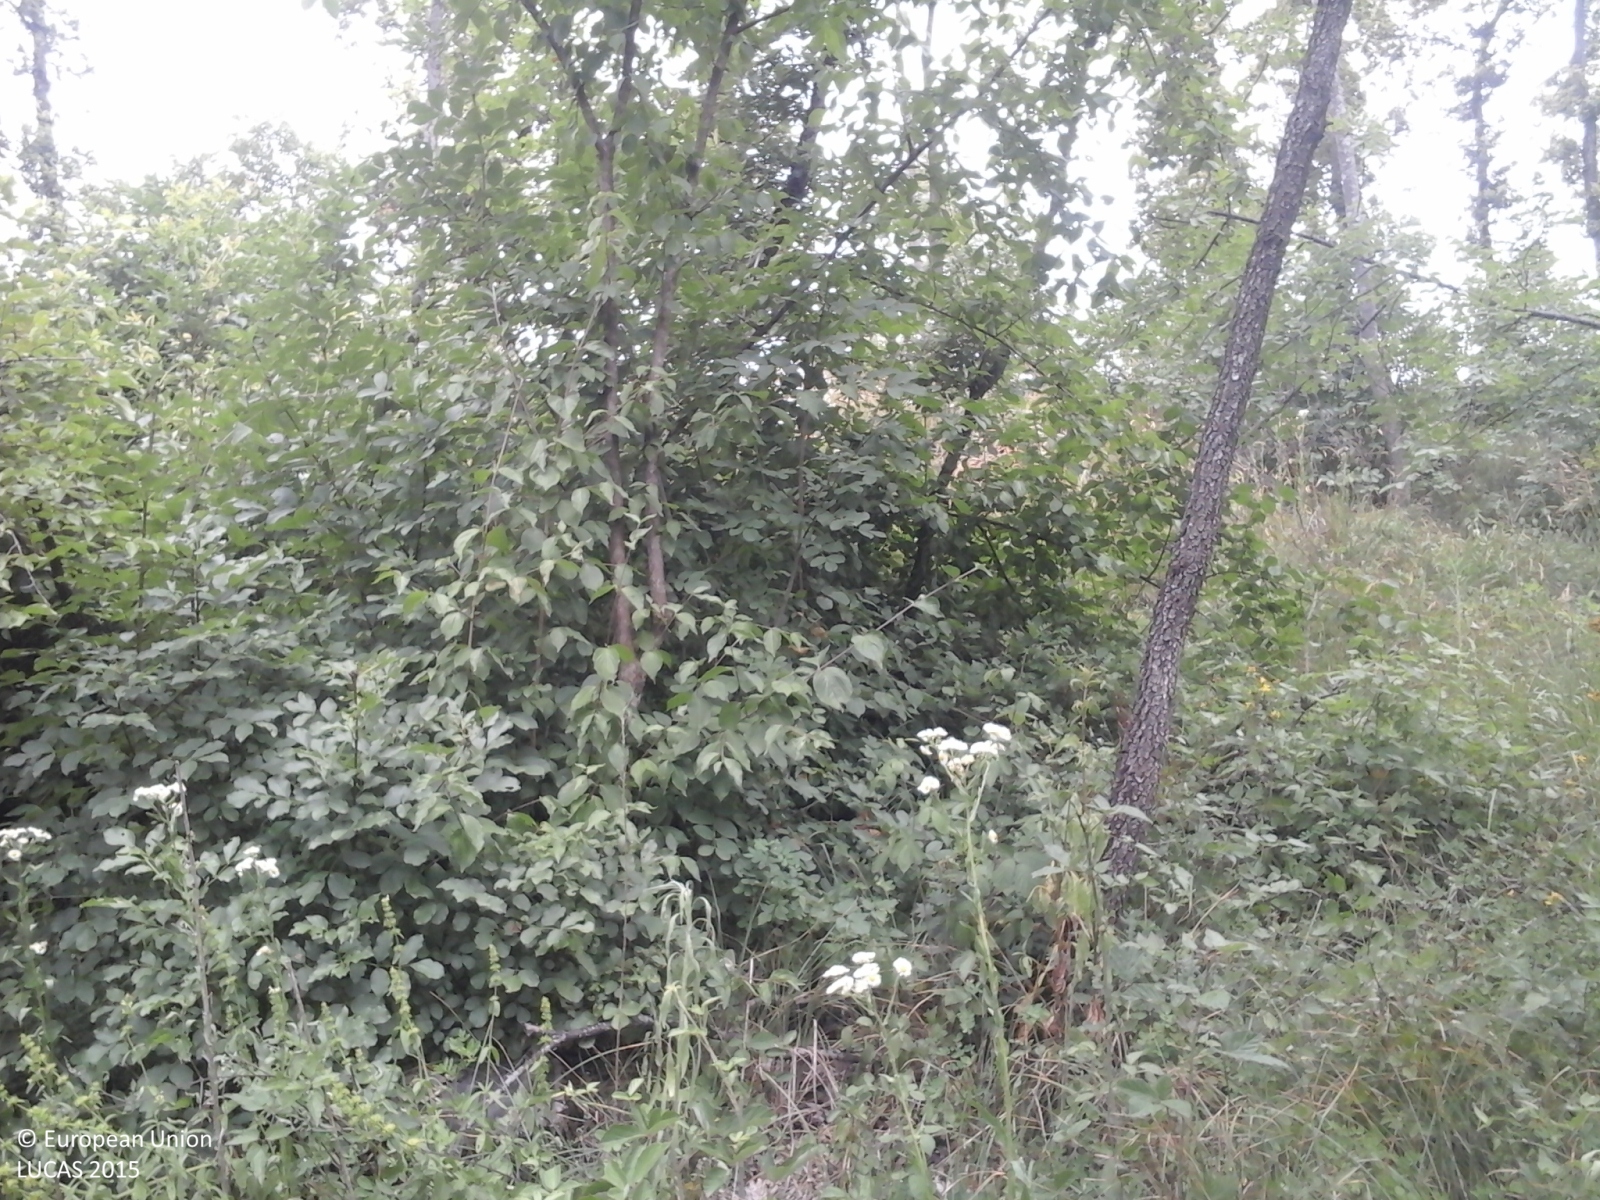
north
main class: Woodland
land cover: Broadleaved woodland
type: thermophilous deciduous forest
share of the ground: > 75 %
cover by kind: broadleaved forest trees 100 %
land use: Forestry
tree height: > 5 m
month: June
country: IT
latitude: 44.5667
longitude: 10.2387
